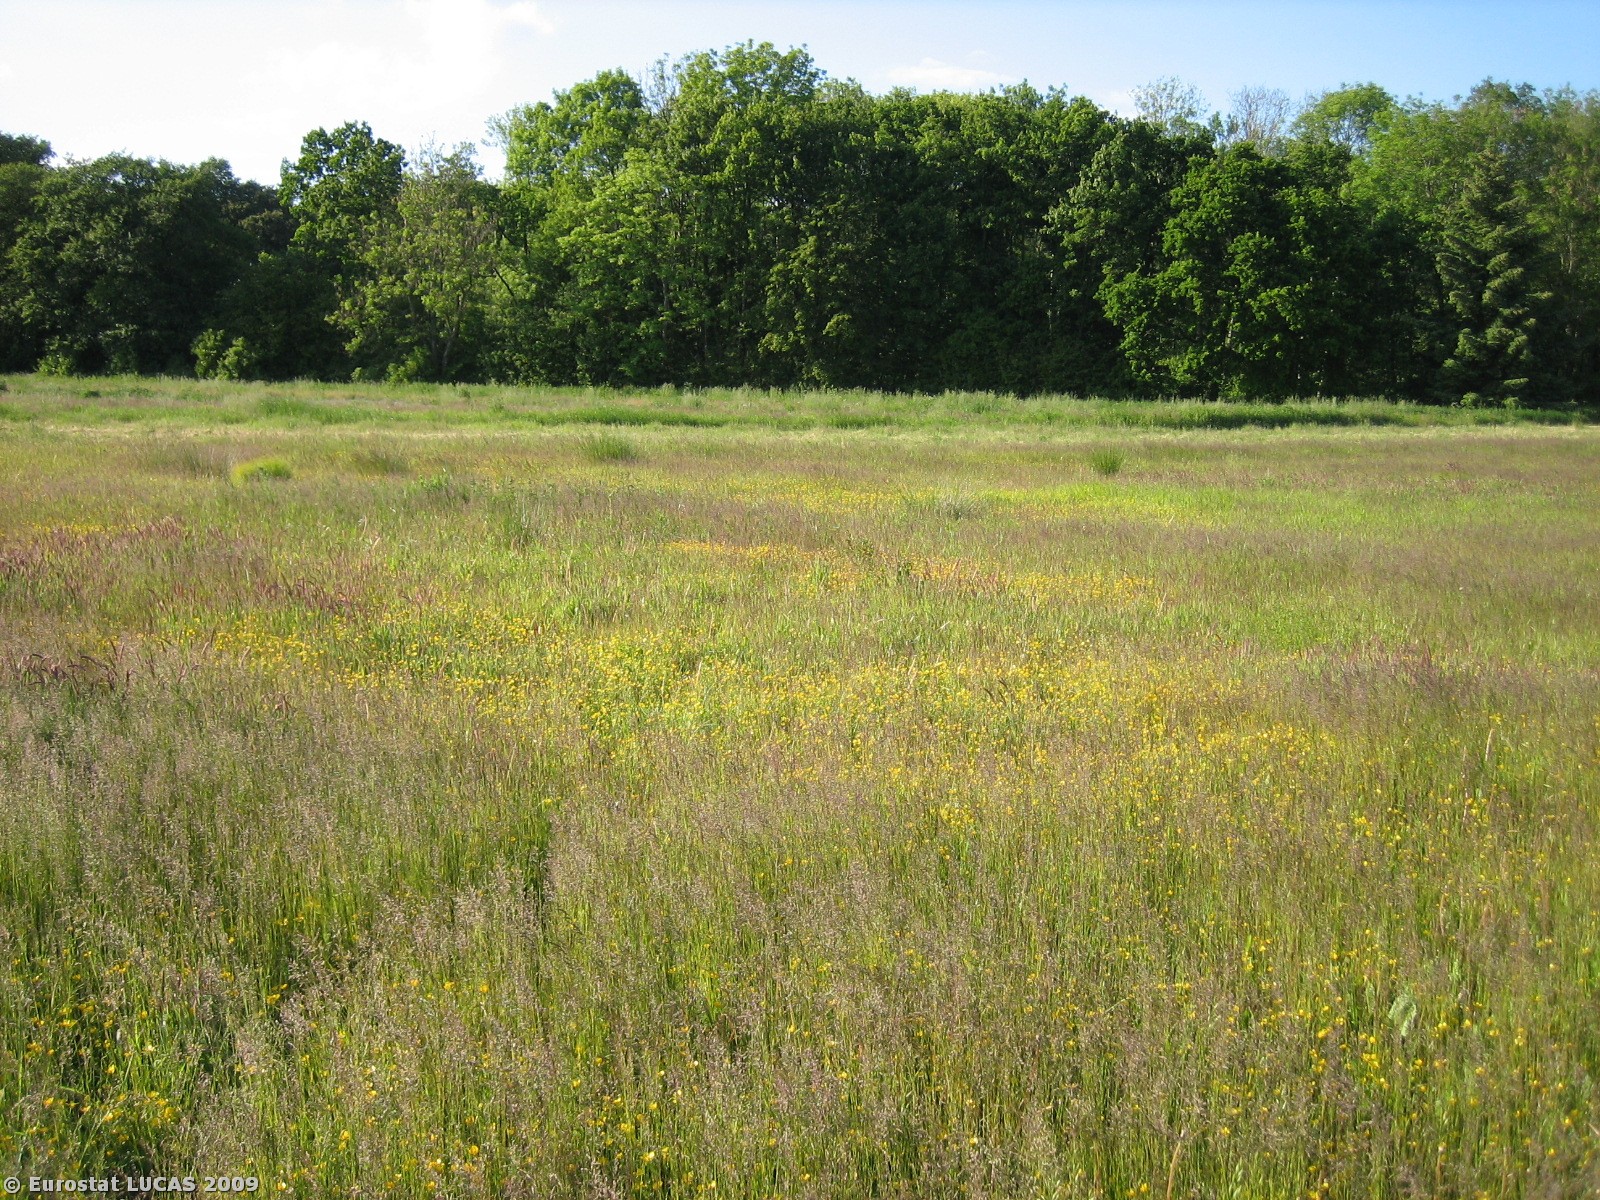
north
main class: Grassland
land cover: Grassland without tree/shrub cover
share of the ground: > 75 %
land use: Unused
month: June
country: DK
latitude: 56.1697
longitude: 9.9196
